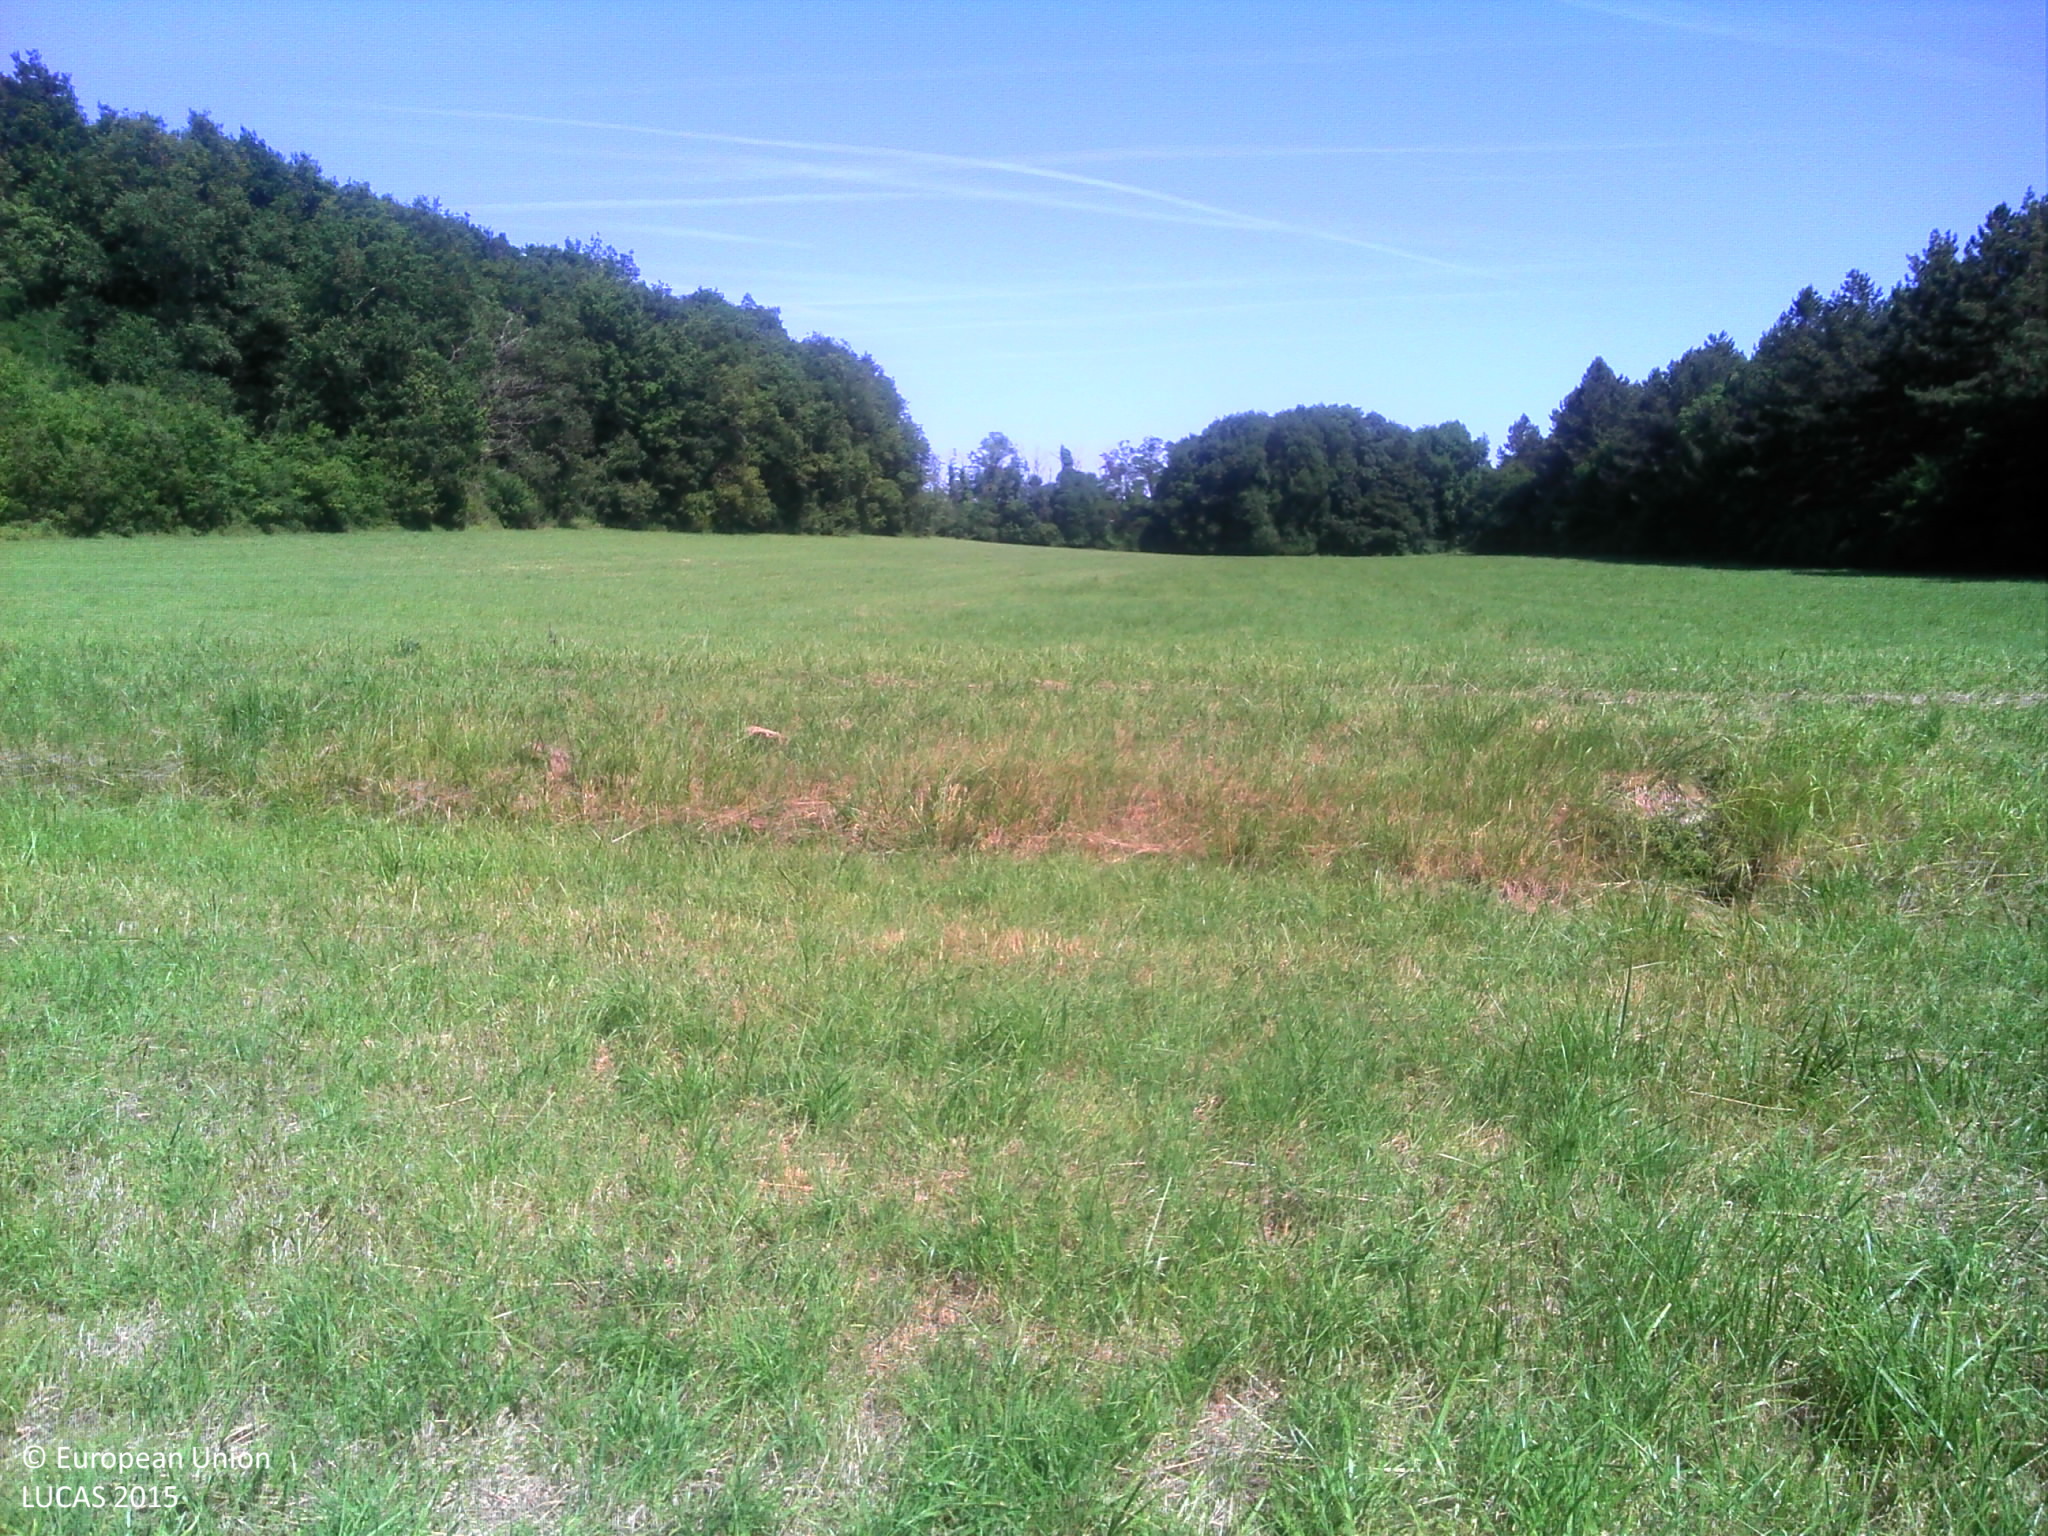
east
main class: Grassland
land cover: Grassland without tree/shrub cover
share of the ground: > 75 %
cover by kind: herbaceous plants 100 %
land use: Agriculture (excluding fallow land and kitchen gardens)
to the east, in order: Grassland without tree/shrub cover; Ditches and canals; Tracks; Ditches and canals; Grassland without tree/shrub cover; Fences; Broadleaved woodland
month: June
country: FR
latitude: 45.7550
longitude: -0.7341
